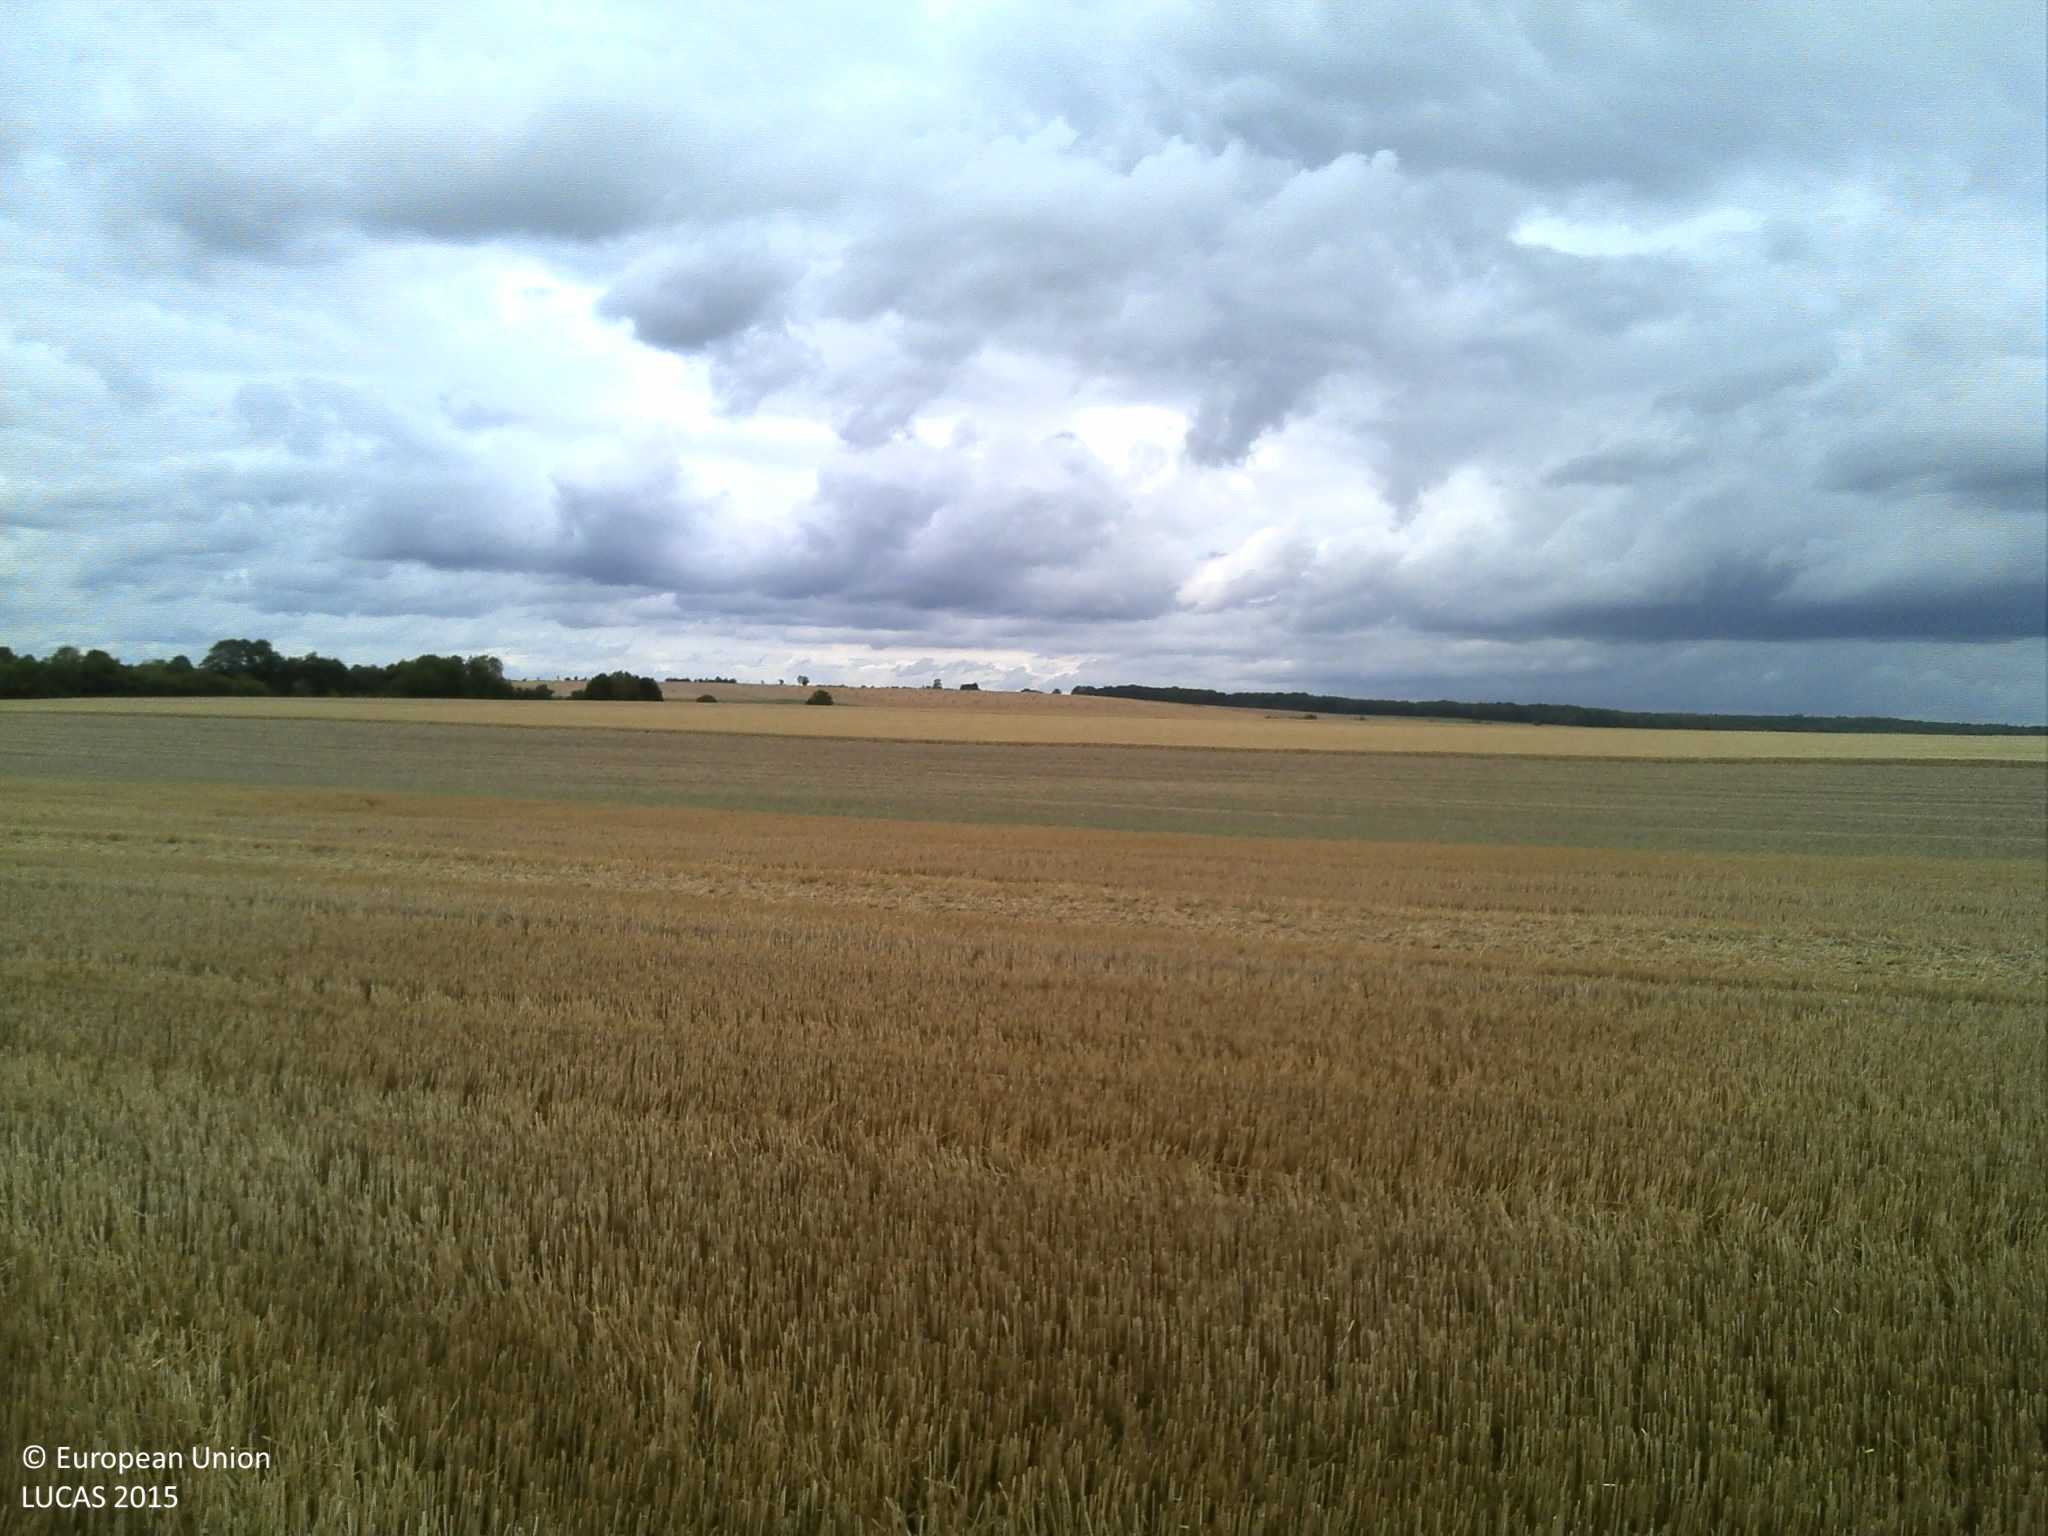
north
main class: Cropland
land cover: Common wheat
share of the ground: 50 - 75 %
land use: Agriculture (excluding fallow land and kitchen gardens)
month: July
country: FR
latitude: 49.4809
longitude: 4.6274
